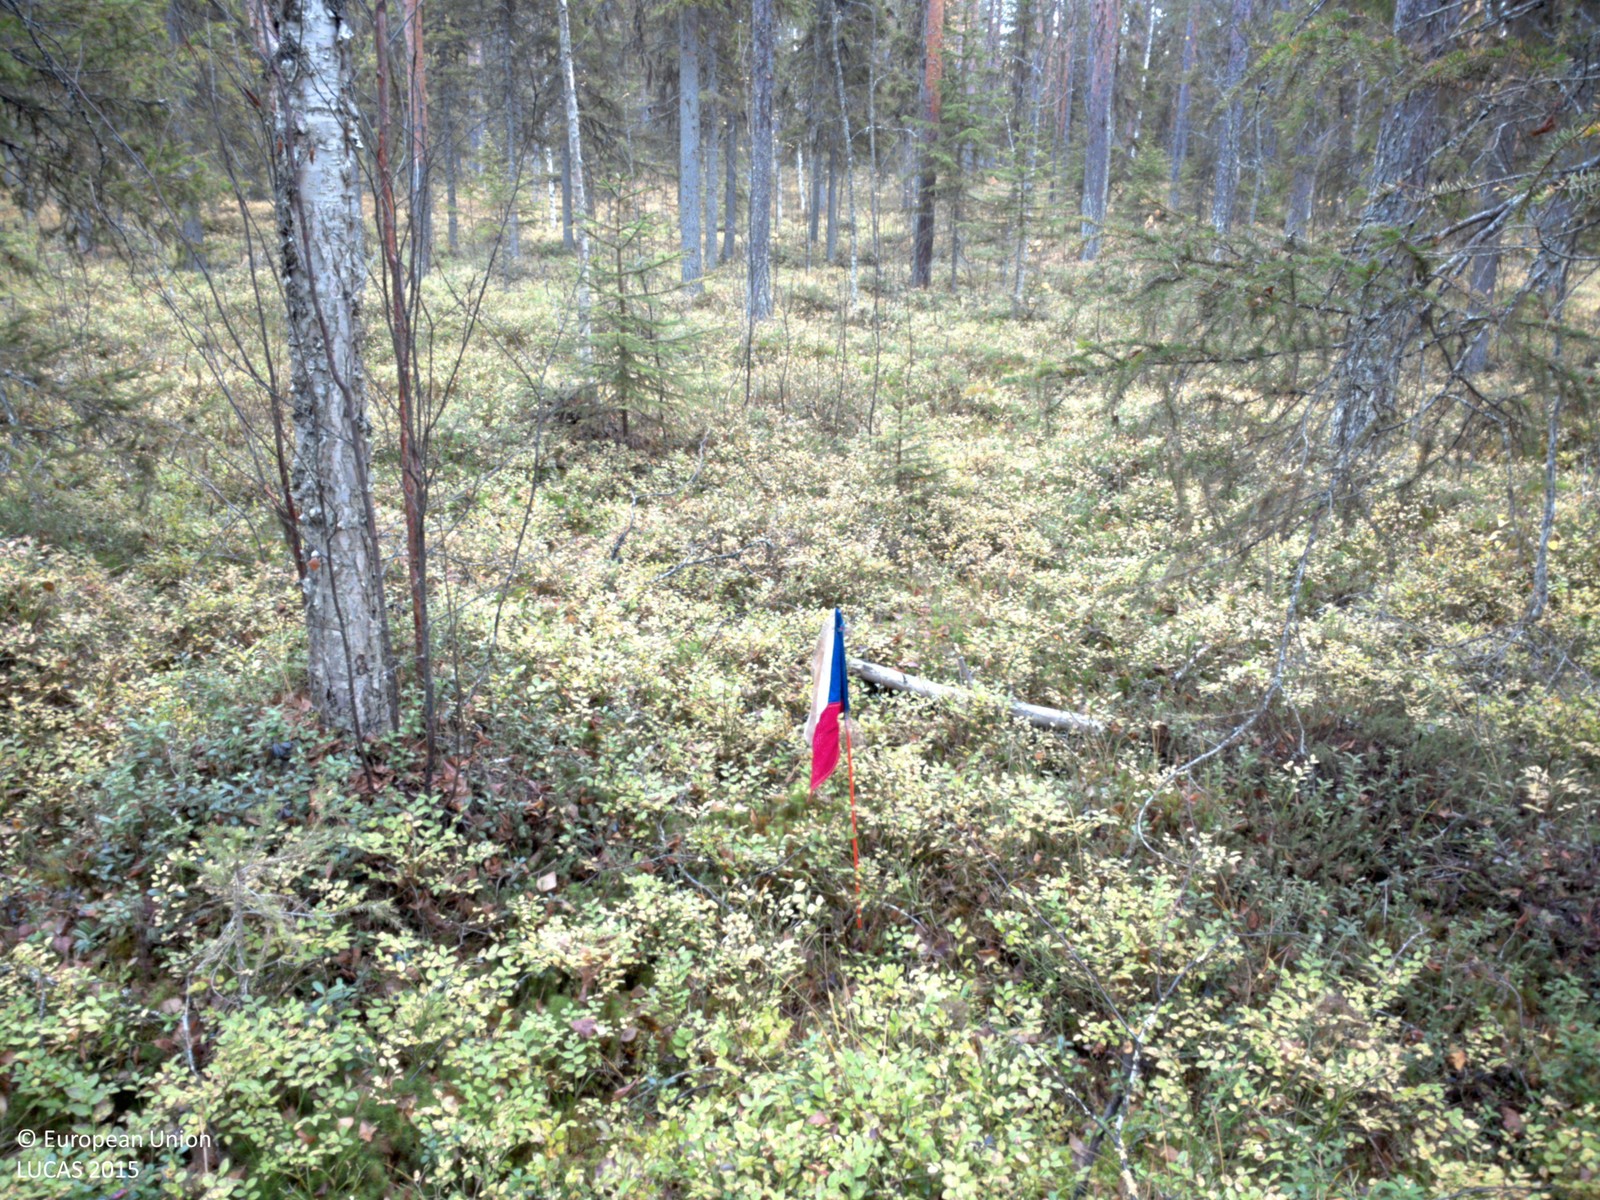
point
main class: Woodland
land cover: Spruce dominated coniferous woodland
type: boreal forest
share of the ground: > 75 %
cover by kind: coniferous forest trees 70 %, shrubs 20 %, broadleaved forest trees 5 %, lichens and mosses 5 %
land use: Forestry
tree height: > 5 m
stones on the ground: < 10 %
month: October
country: SE
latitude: 64.9494
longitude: 18.1981
